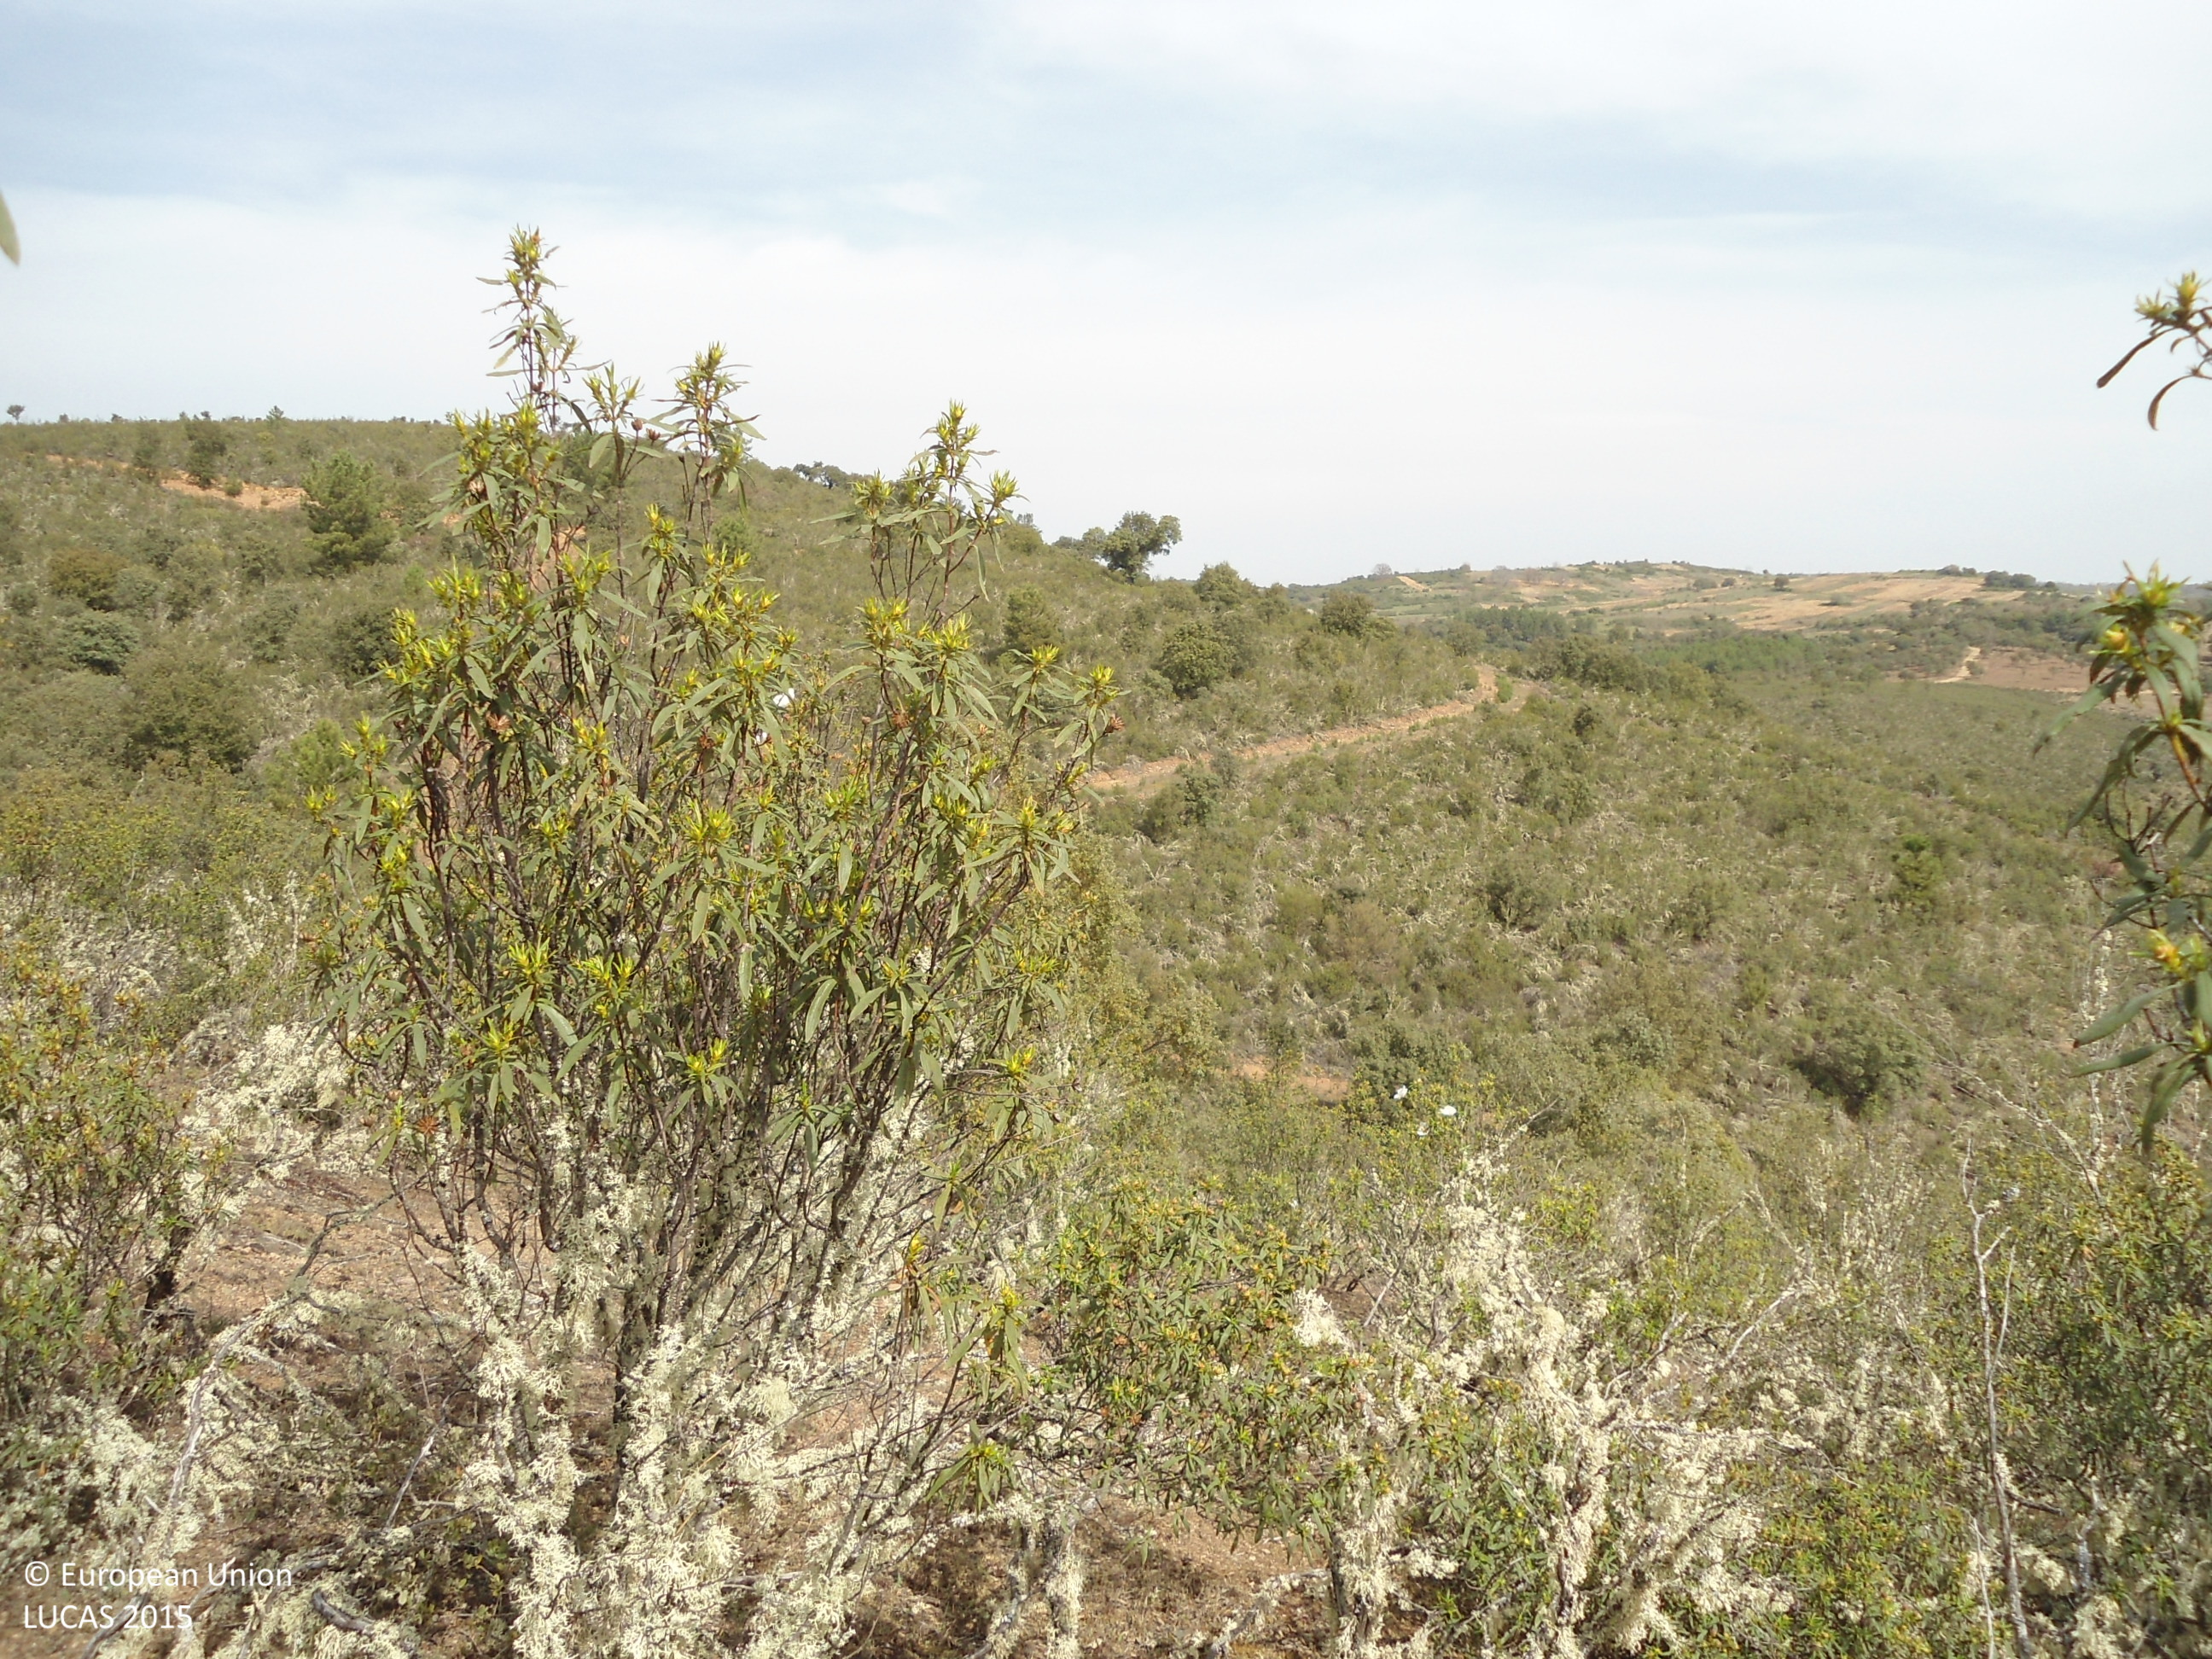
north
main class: Shrubland
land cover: Shrubland with sparse tree cover
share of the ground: > 75 %
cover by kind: shrubs 95 %, coniferous forest trees 5 %
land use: Forestry
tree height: < 5 m
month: April
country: ES
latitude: 41.8244
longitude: -6.4933
